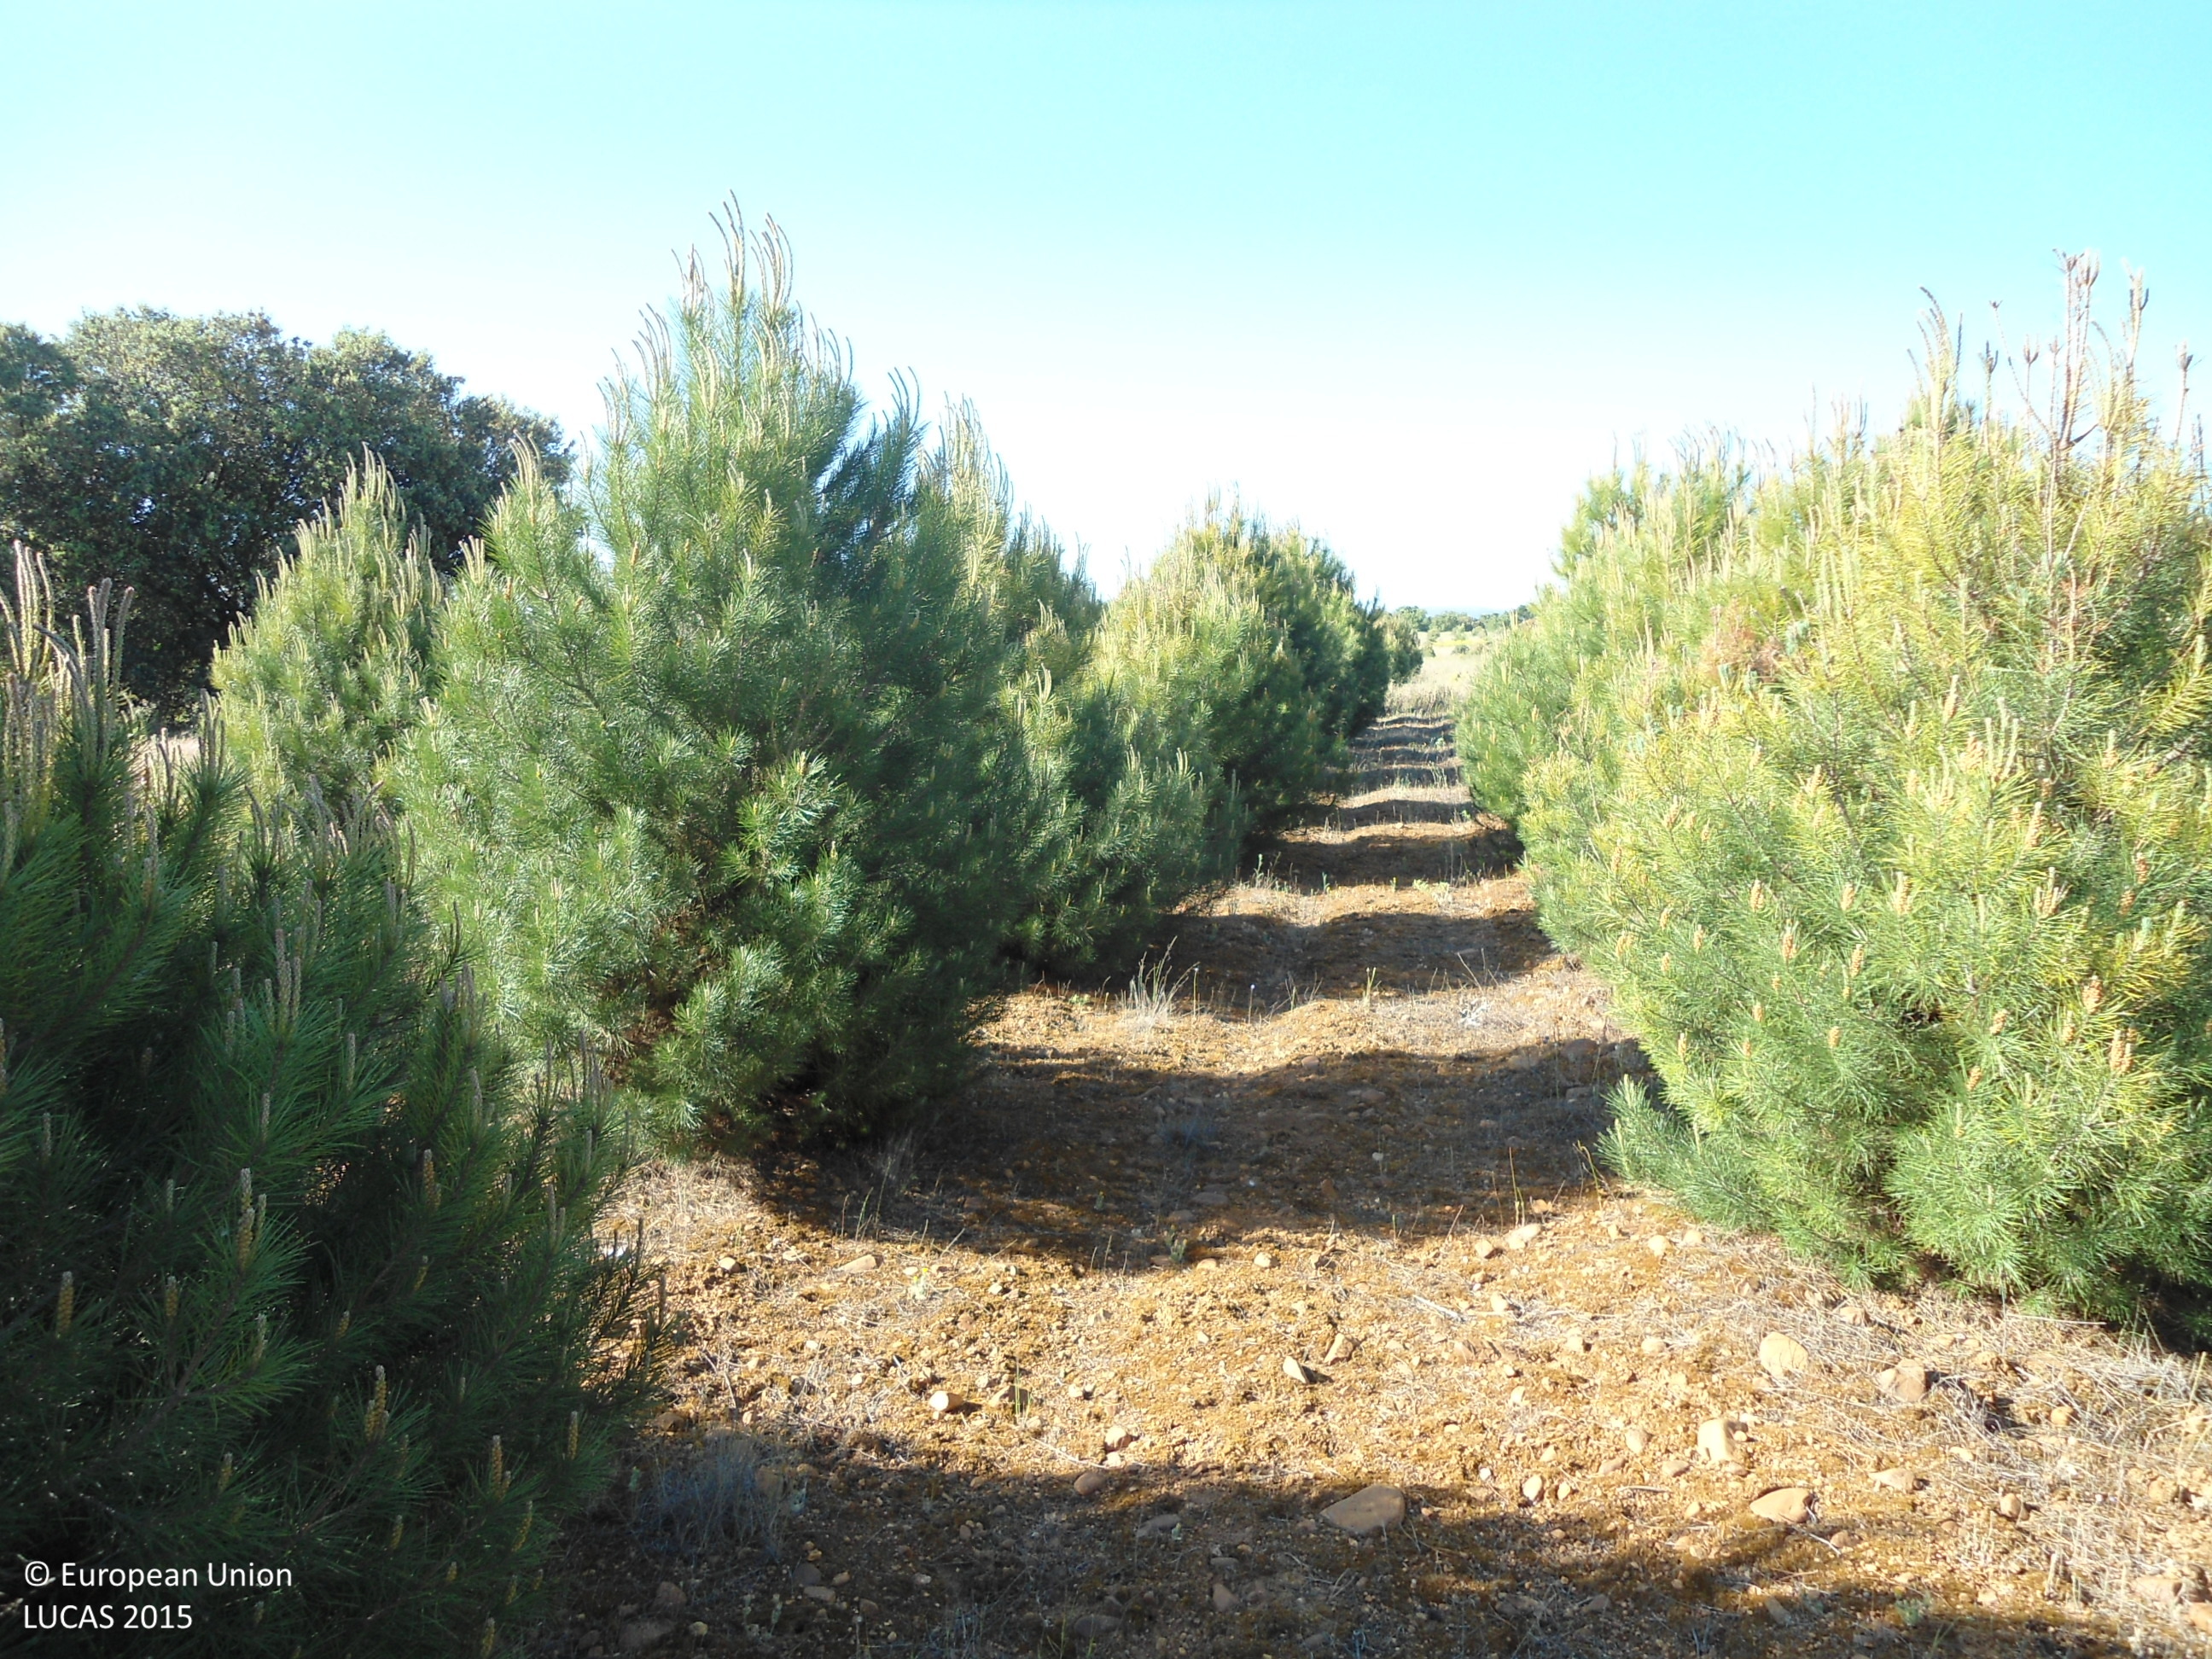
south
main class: Woodland
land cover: Pine dominated coniferous woodland
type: coniferous forest of the mediterranean region
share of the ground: 50 - 75 %
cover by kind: coniferous forest trees 65 %, herbaceous plants 35 %
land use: Forestry
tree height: < 5 m
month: May
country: ES
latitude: 42.0152
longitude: -6.0025
